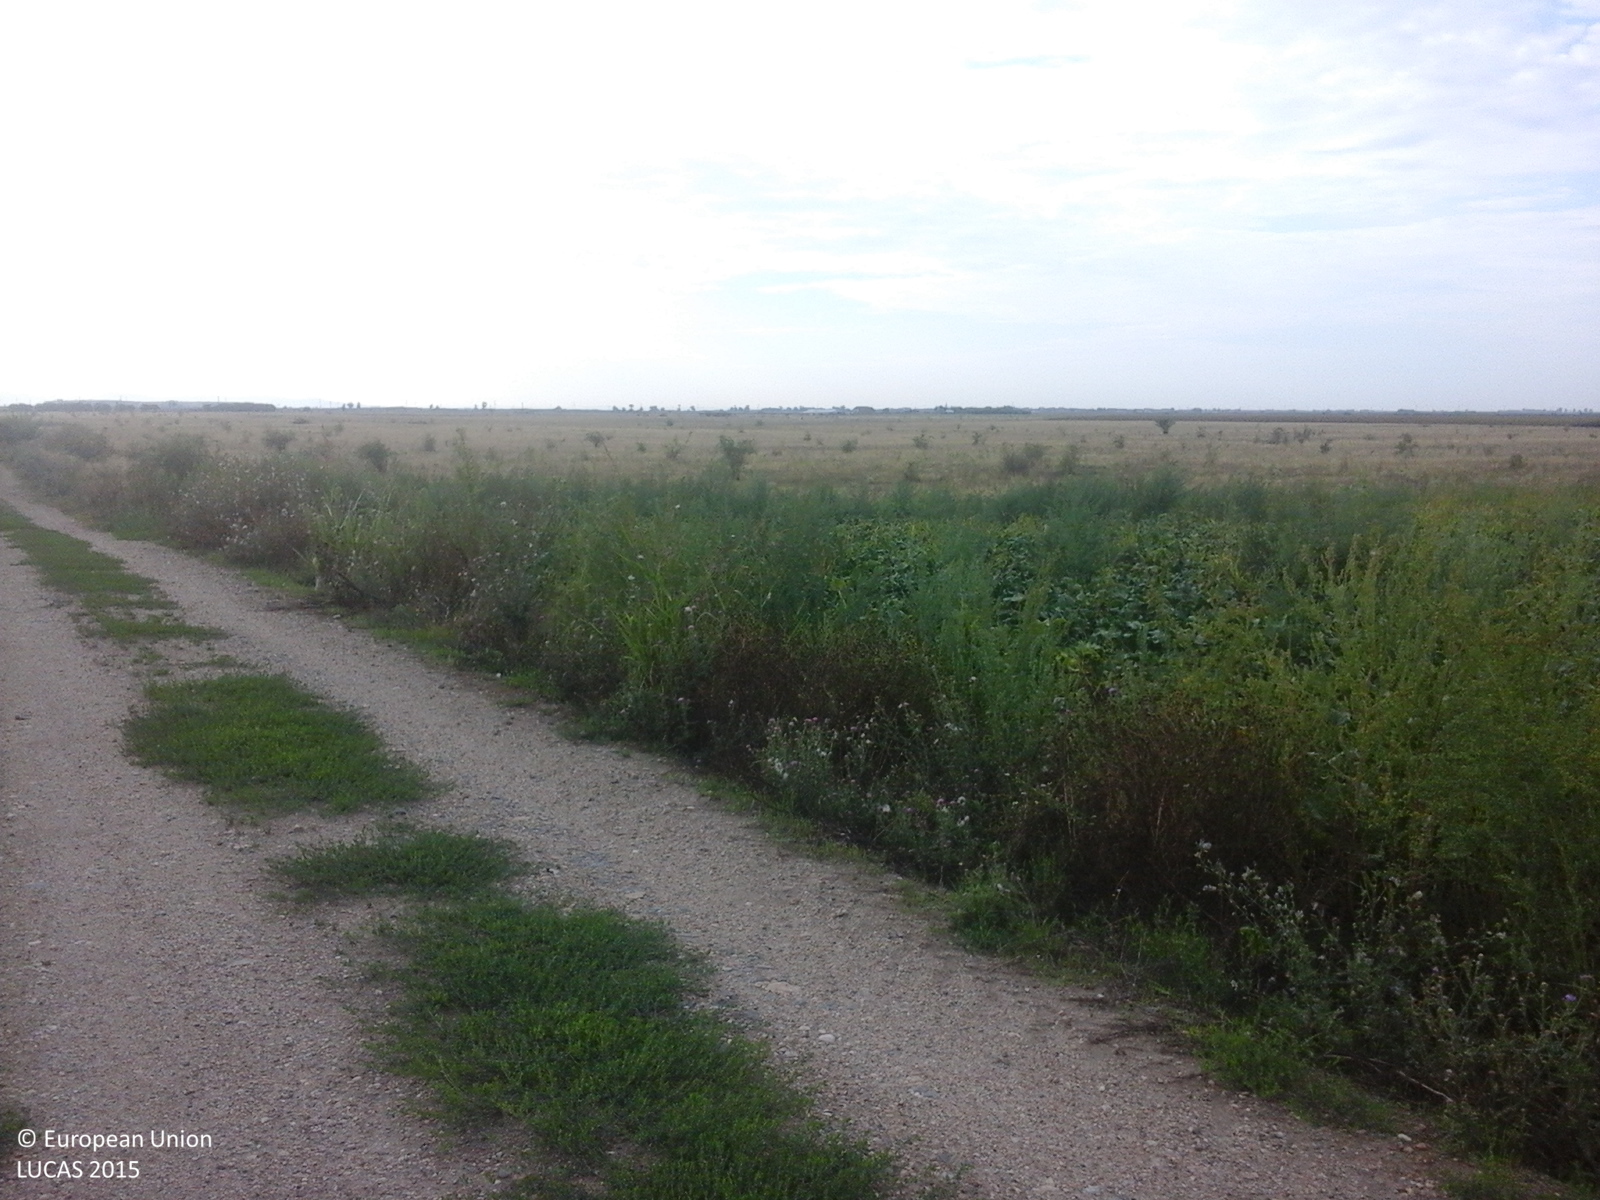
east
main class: Cropland
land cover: Sunflower
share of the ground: > 75 %
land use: Agriculture (excluding fallow land and kitchen gardens)
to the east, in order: Sunflower; Maize
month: August
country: RO
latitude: 46.2886
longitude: 21.3667
